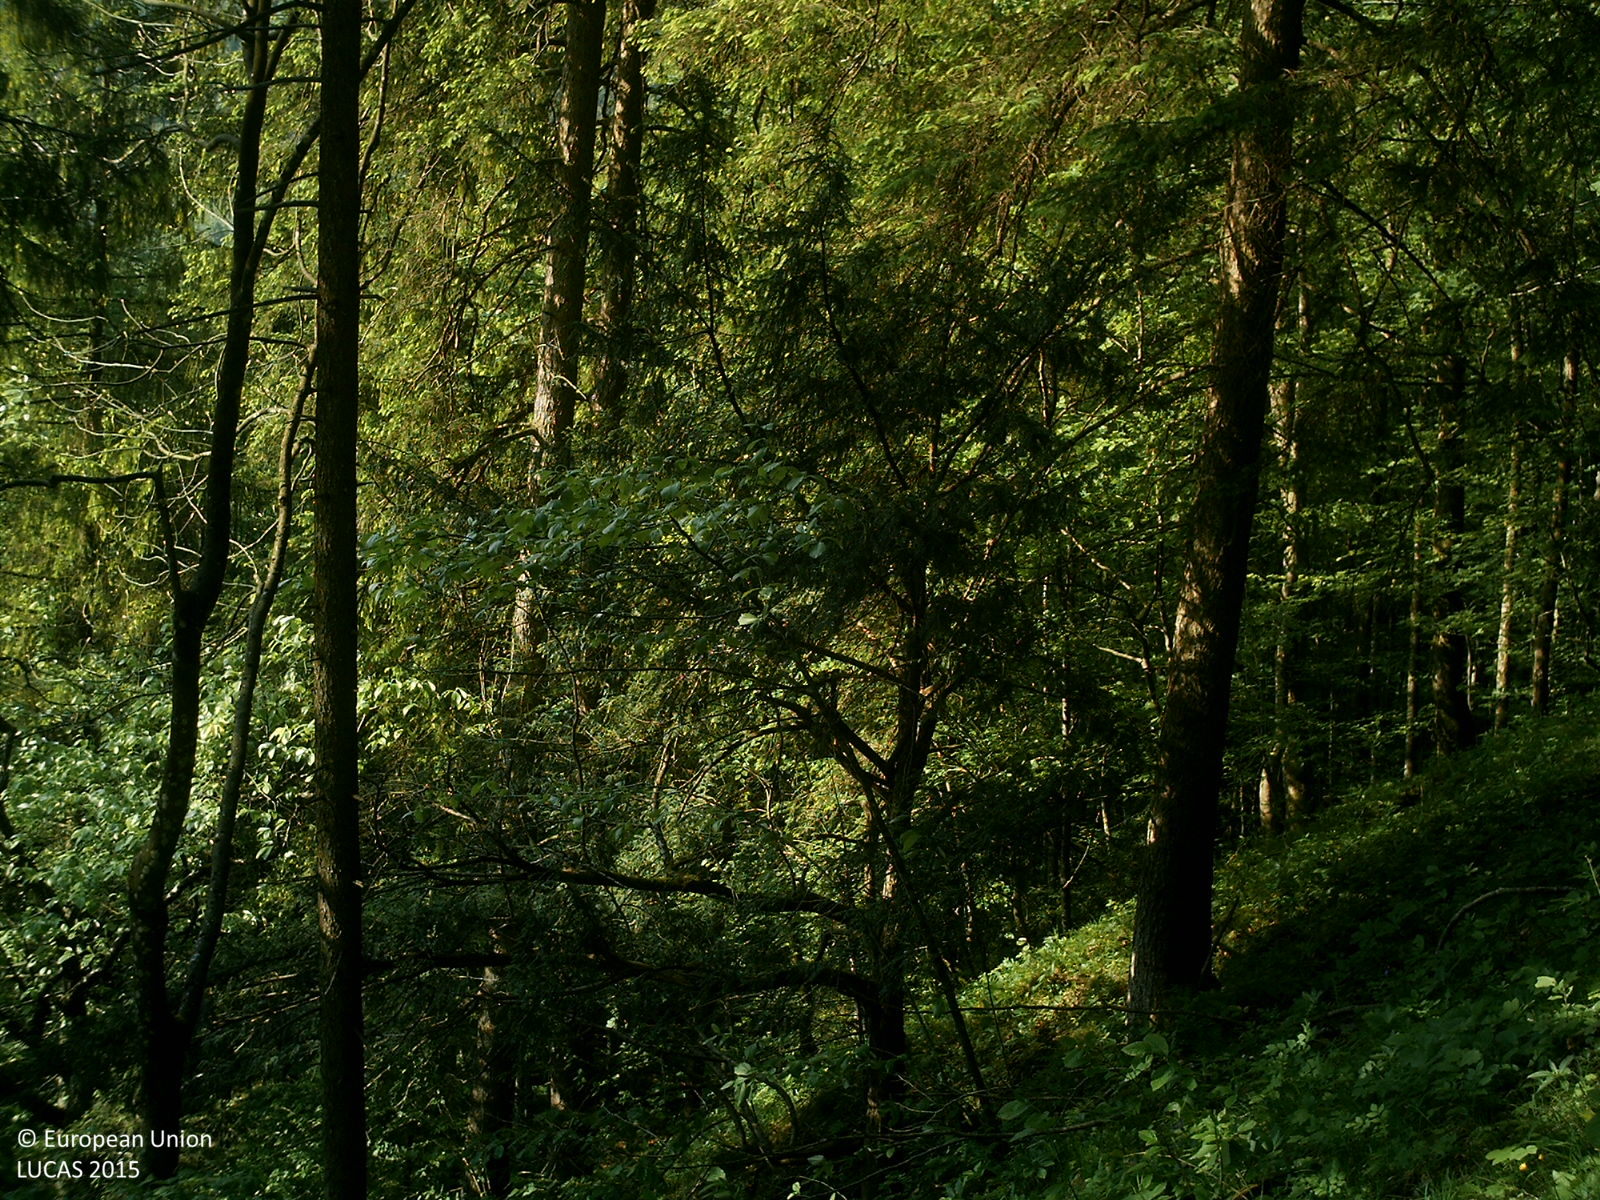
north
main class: Woodland
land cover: Other mixed woodland
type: mountainous beech forest
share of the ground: > 75 %
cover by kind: broadleaved forest trees 60 %, coniferous forest trees 35 %, shrubs 5 %
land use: Forestry
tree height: > 5 m
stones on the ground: < 10 %
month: May
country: AT
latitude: 47.8877
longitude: 14.2925
